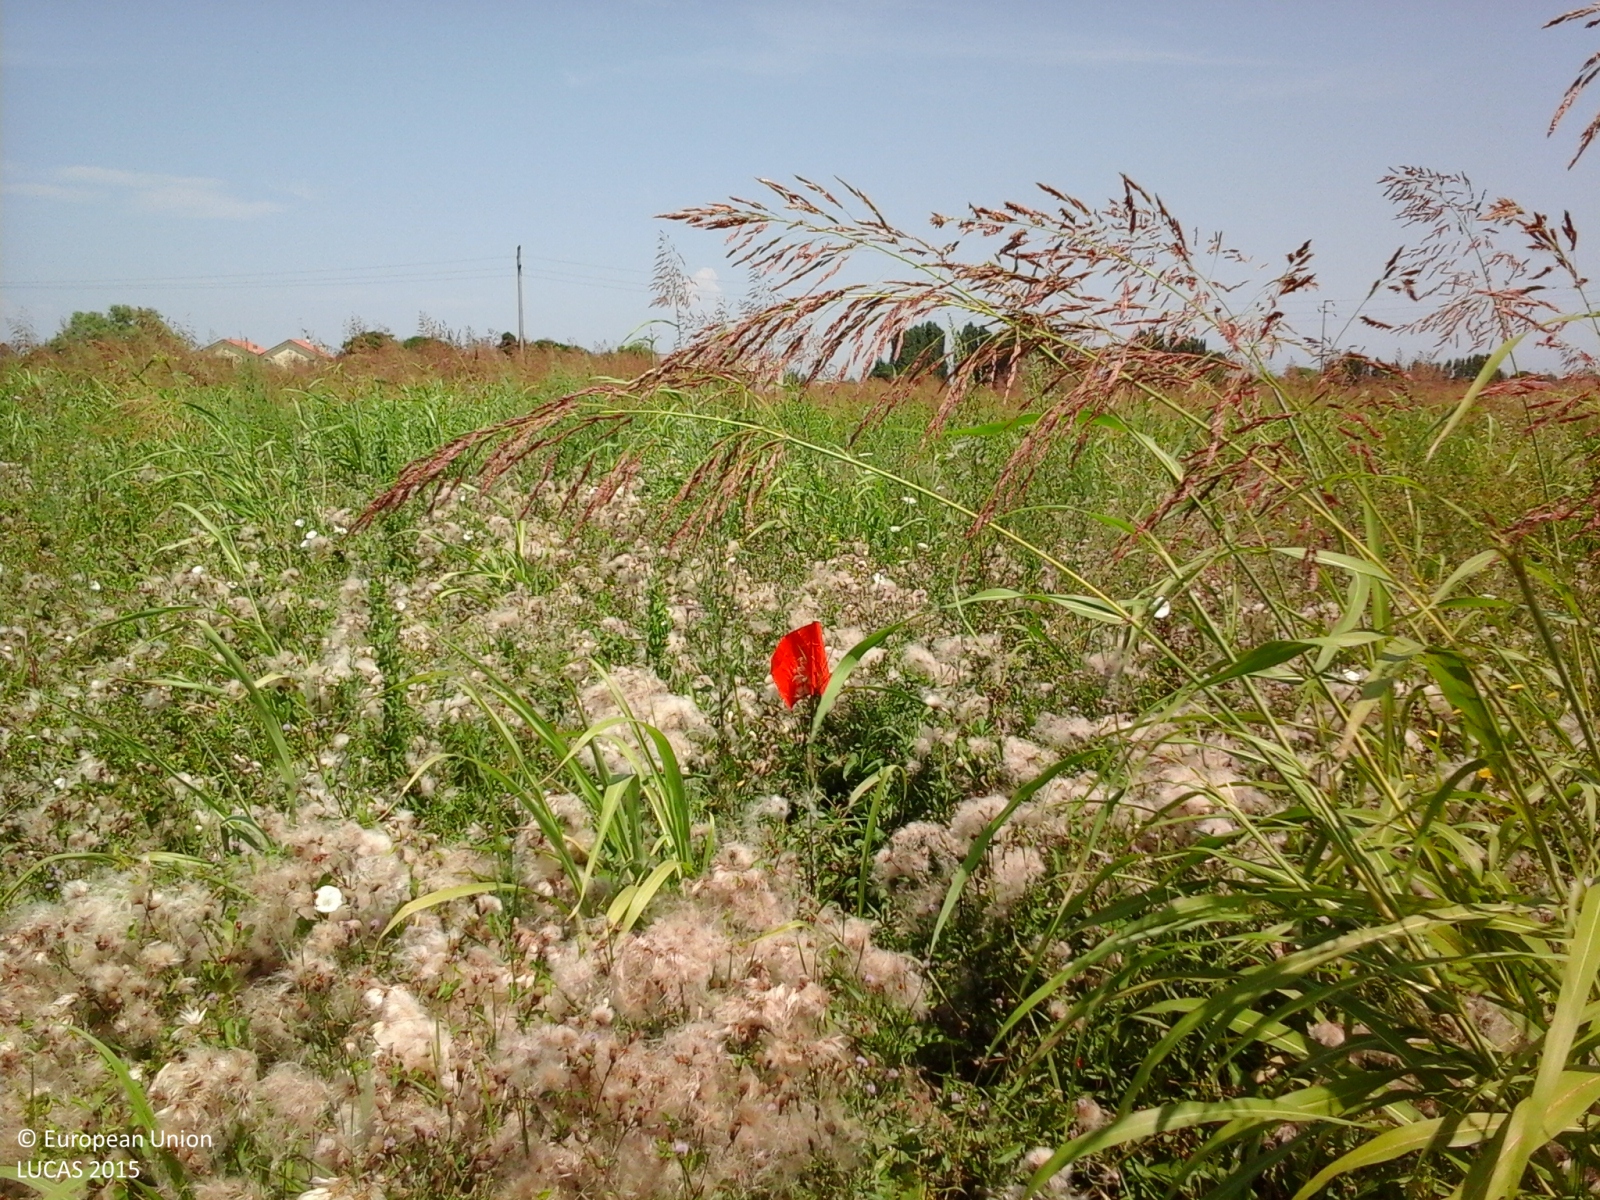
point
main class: Grassland
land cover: Spontaneously vegetated surfaces
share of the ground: > 75 %
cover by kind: herbaceous plants 100 %
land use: Fallow land
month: July
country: IT
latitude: 45.1554
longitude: 12.2730
